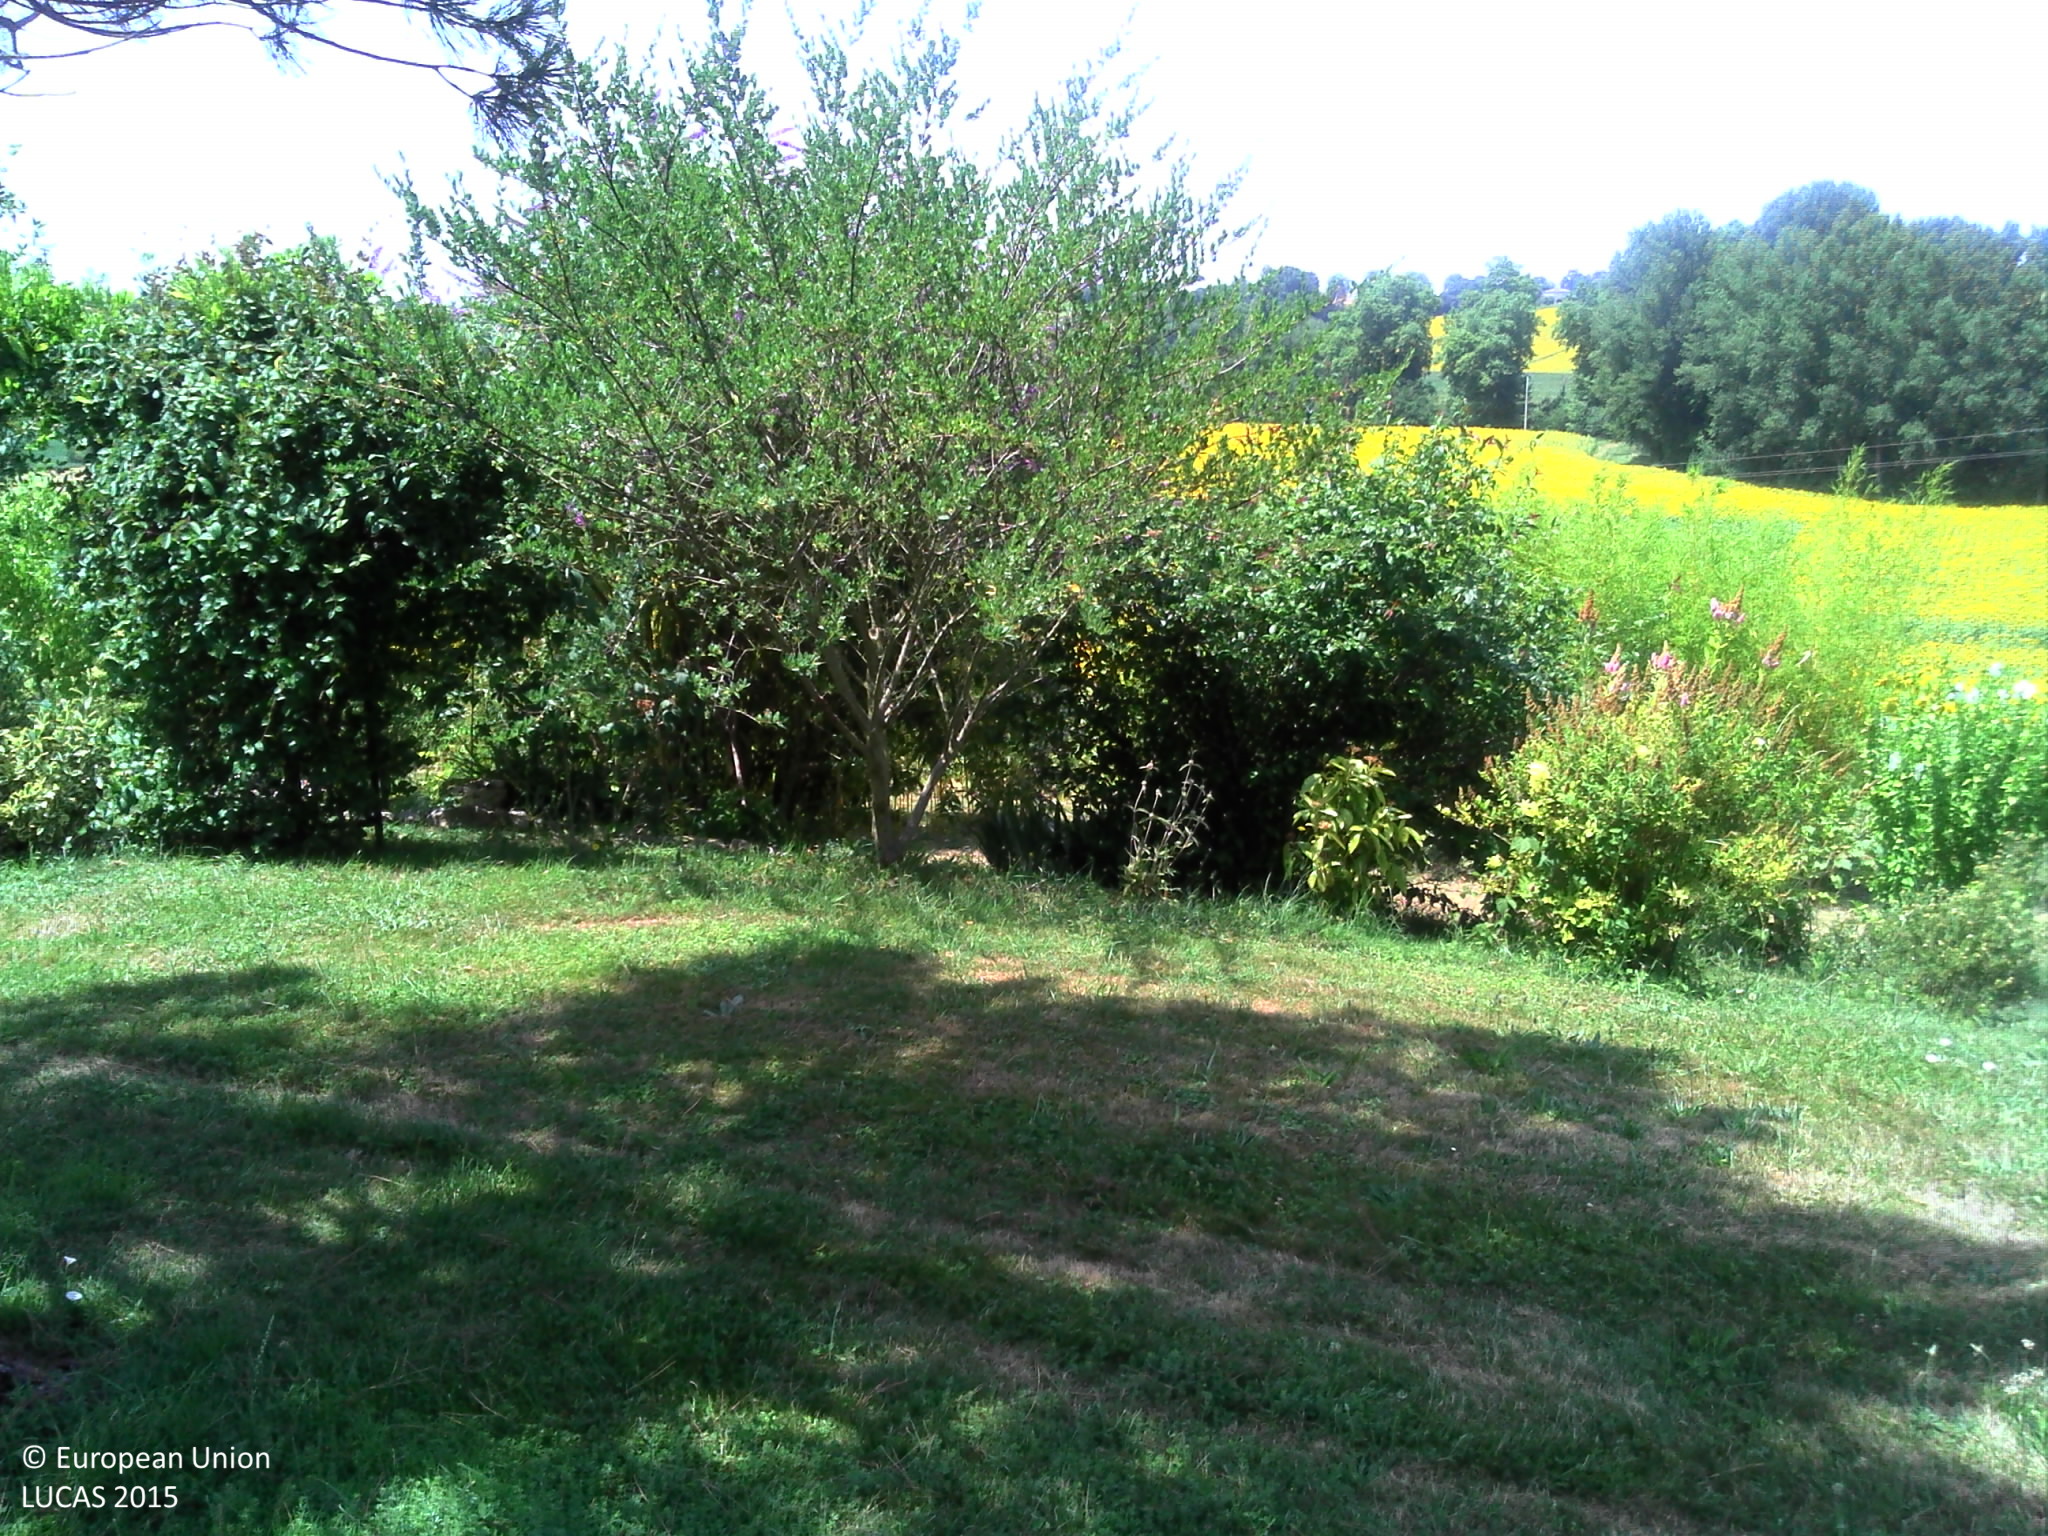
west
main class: Grassland
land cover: Grassland with sparse tree/shrub cover
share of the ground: > 75 %
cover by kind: herbaceous plants 85 %, shrubs 10 %, broadleaved forest trees 5 %
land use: Residential
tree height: < 5 m
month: July
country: FR
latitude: 43.4838
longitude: 0.9626
